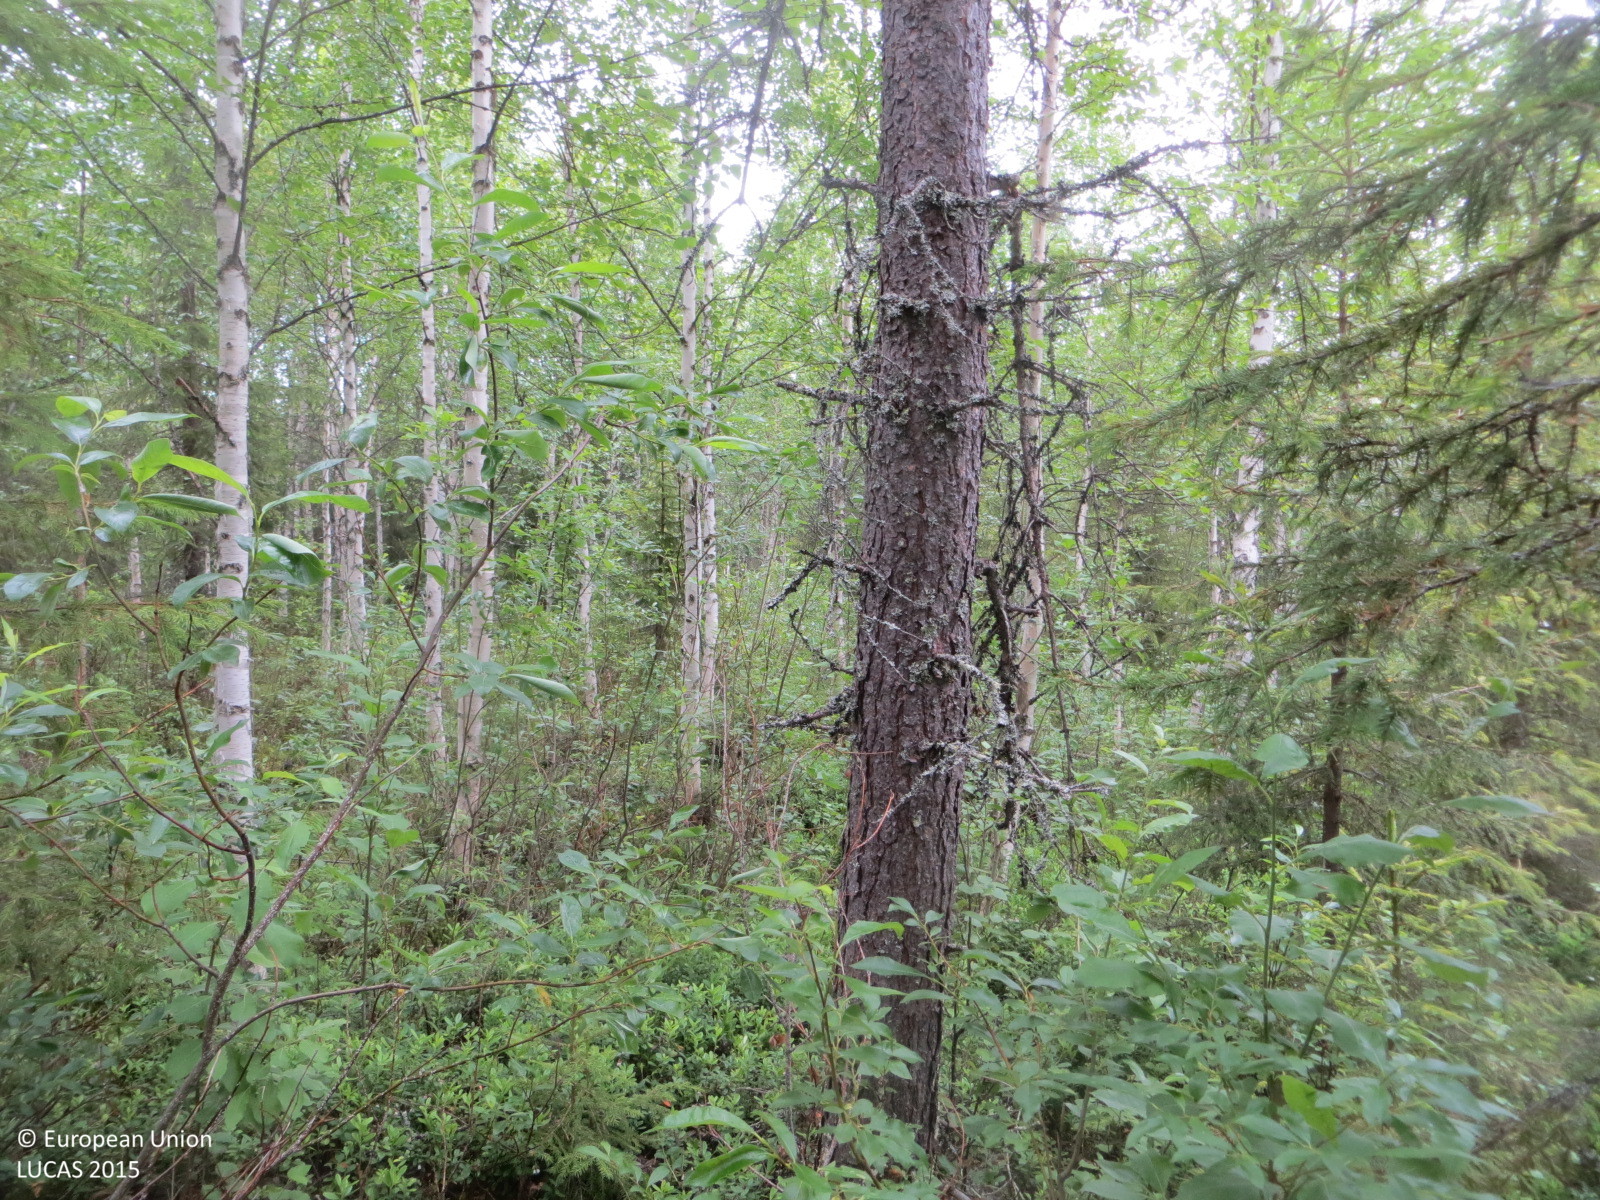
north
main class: Woodland
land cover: Other mixed woodland
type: boreal forest
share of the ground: > 75 %
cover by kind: broadleaved forest trees 45 %, coniferous forest trees 30 %, shrubs 25 %
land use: Forestry
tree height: > 5 m
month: July
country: FI
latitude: 66.4839
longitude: 23.9837
